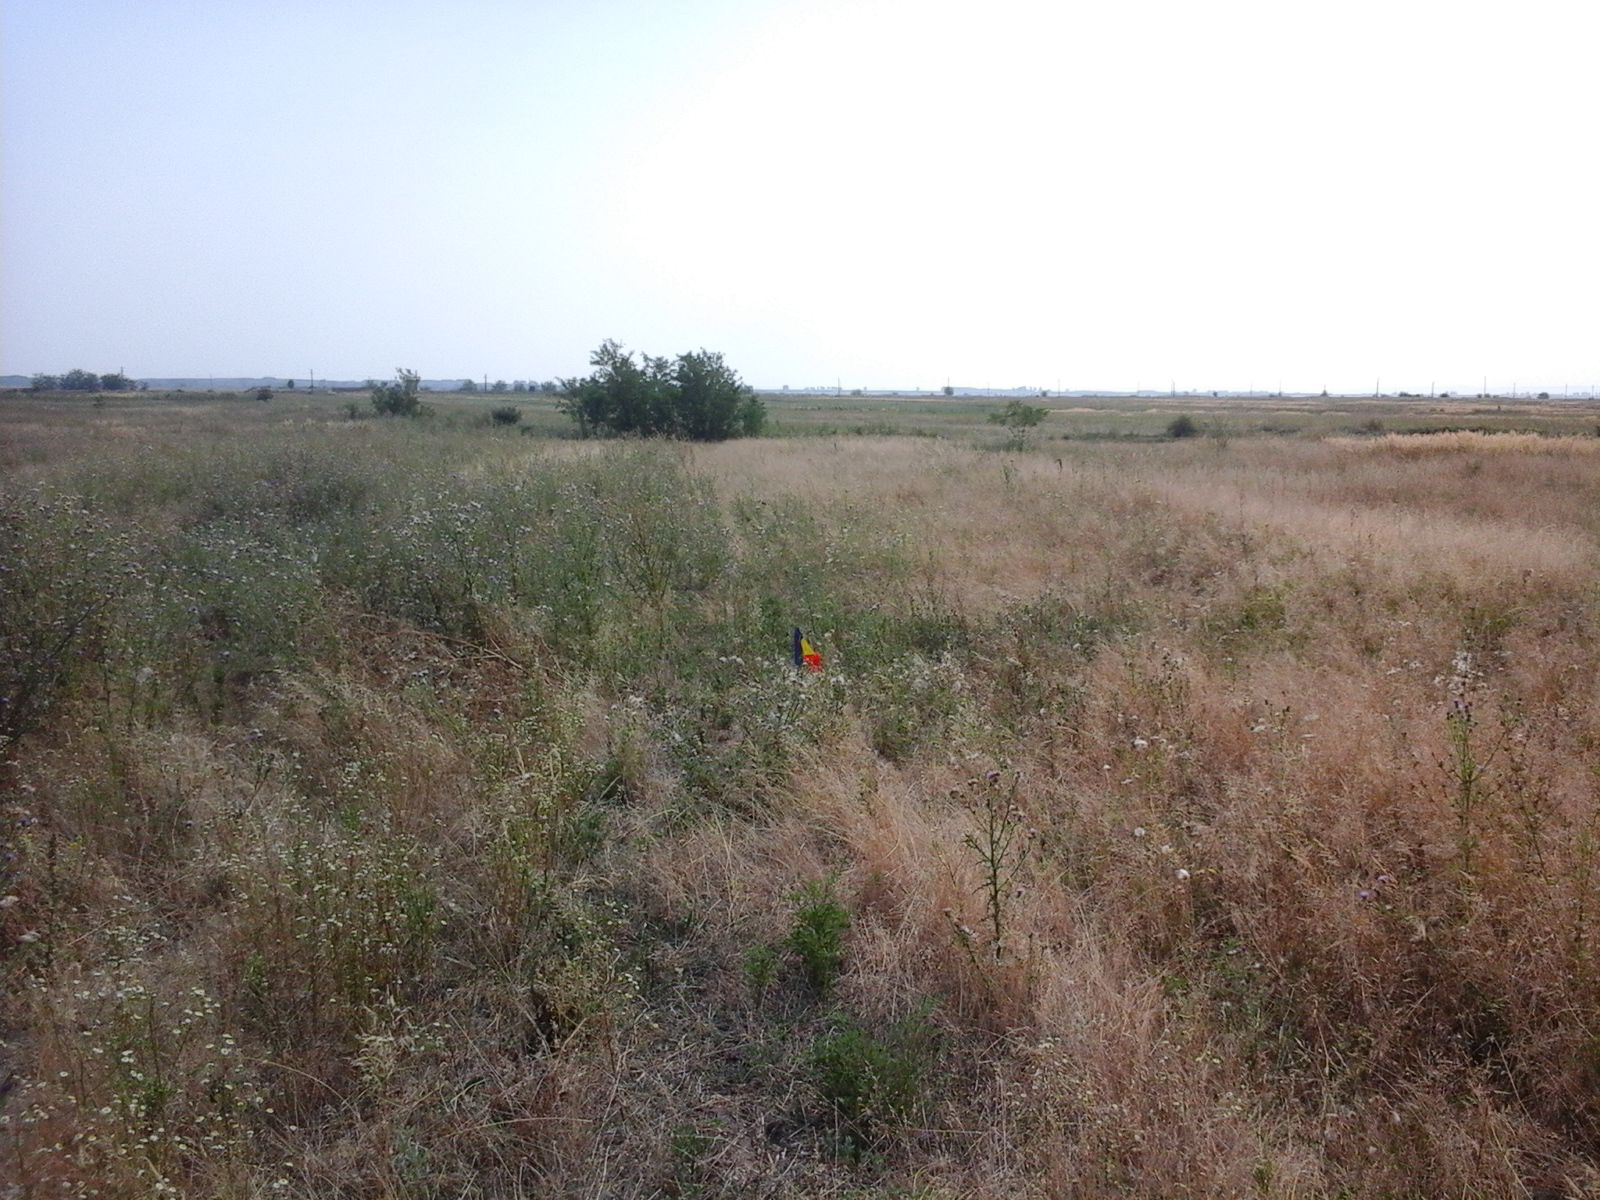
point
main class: Grassland
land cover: Spontaneously vegetated surfaces
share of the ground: > 75 %
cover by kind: herbaceous plants 100 %
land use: Agriculture (excluding fallow land and kitchen gardens)
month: August
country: RO
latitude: 44.4607
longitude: 22.6973
